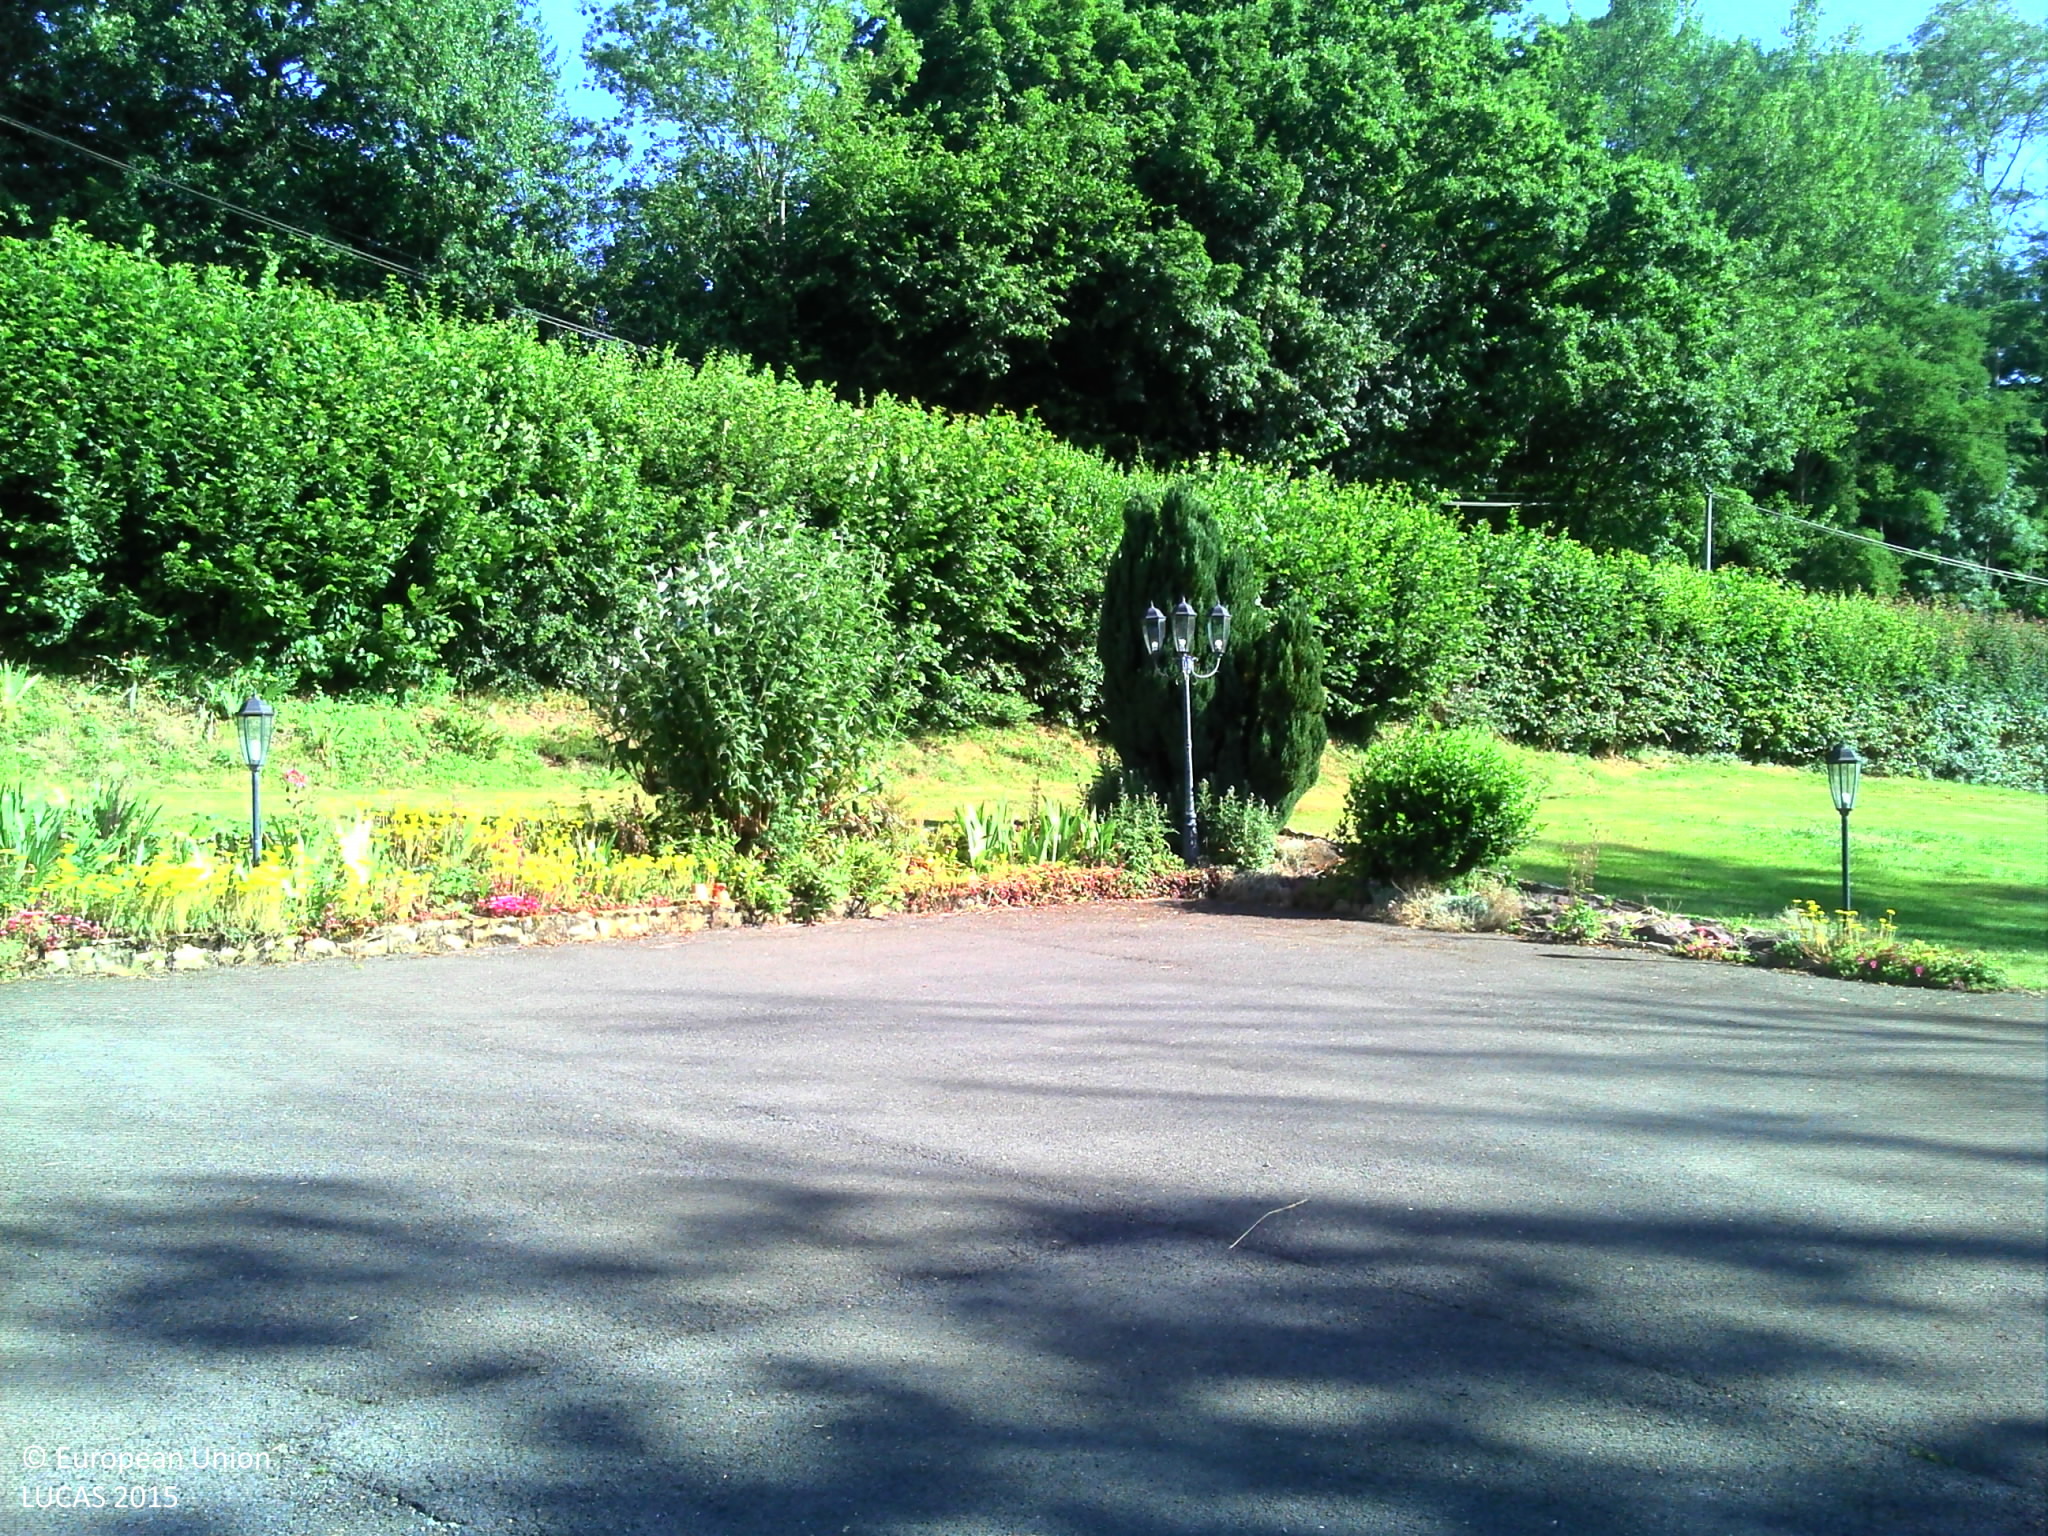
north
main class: Grassland
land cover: Grassland without tree/shrub cover
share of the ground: > 75 %
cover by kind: herbaceous plants 100 %
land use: Residential
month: July
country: FR
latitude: 48.9724
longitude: 0.5069
